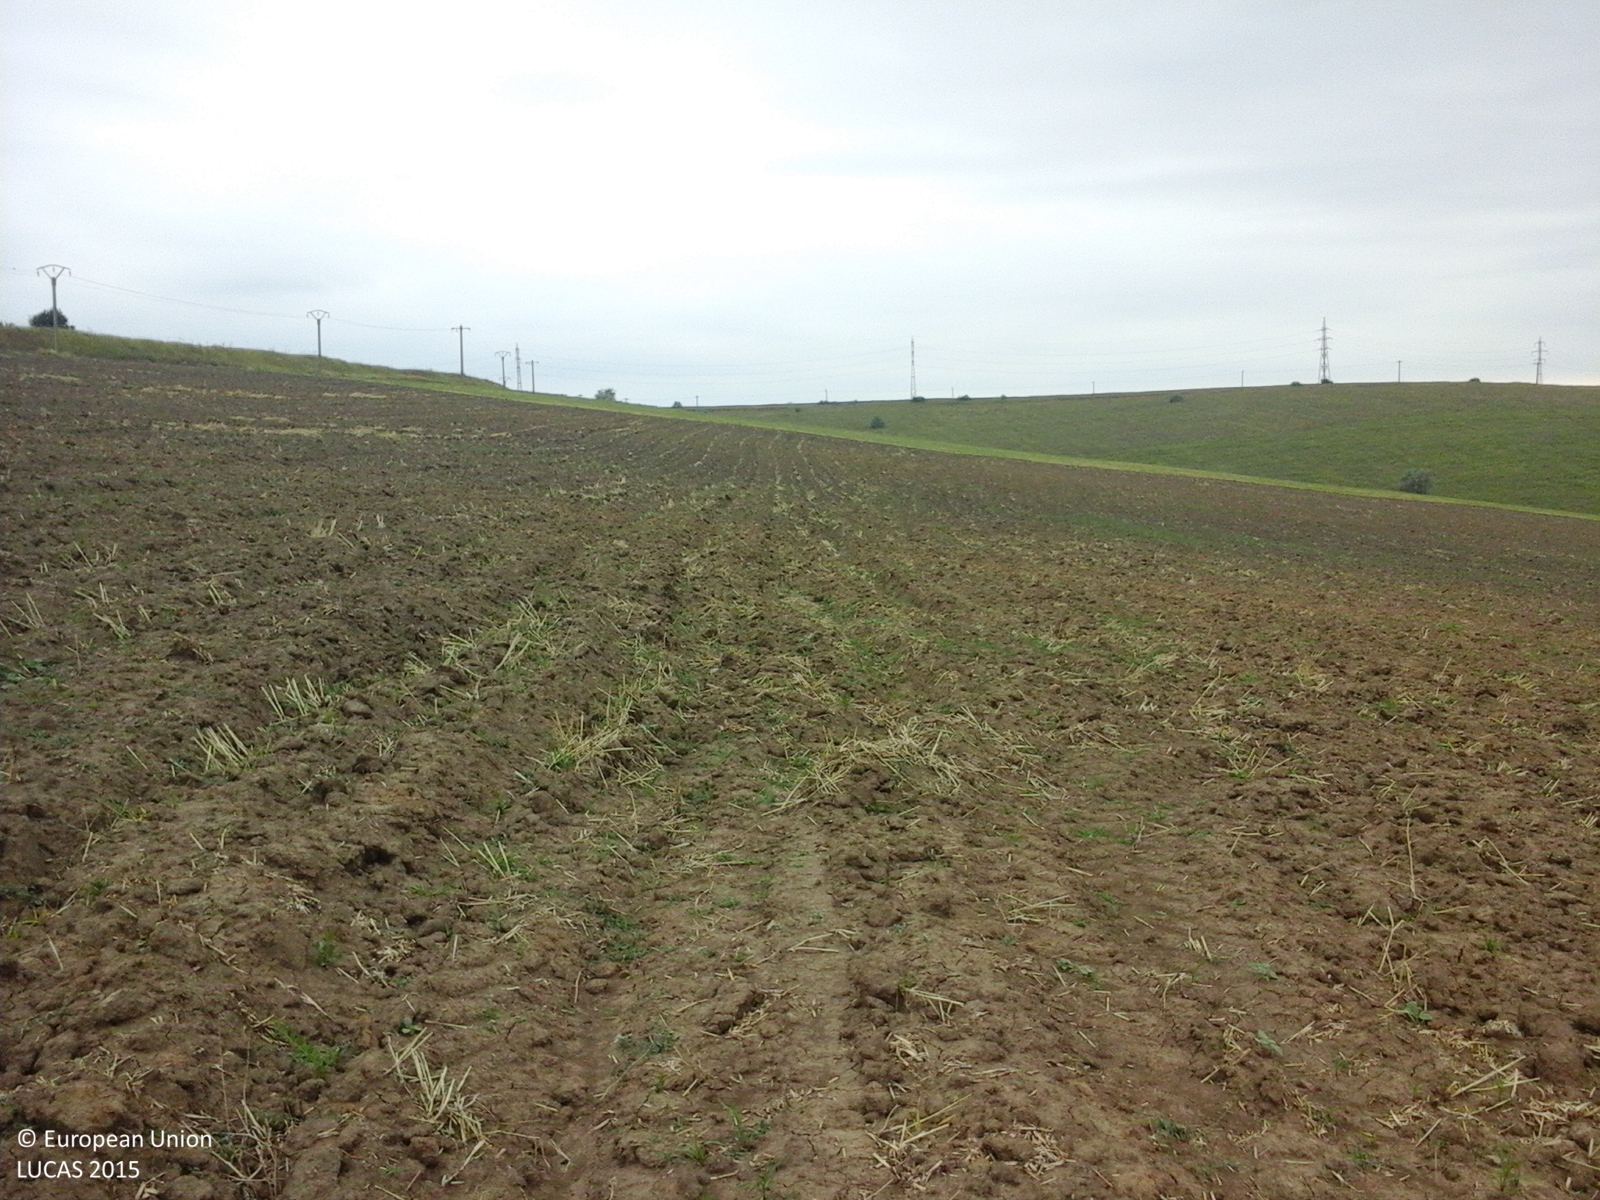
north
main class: Cropland
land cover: Common wheat
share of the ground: < 10 %
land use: Agriculture (excluding fallow land and kitchen gardens)
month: August
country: RO
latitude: 45.1362
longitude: 28.8473
